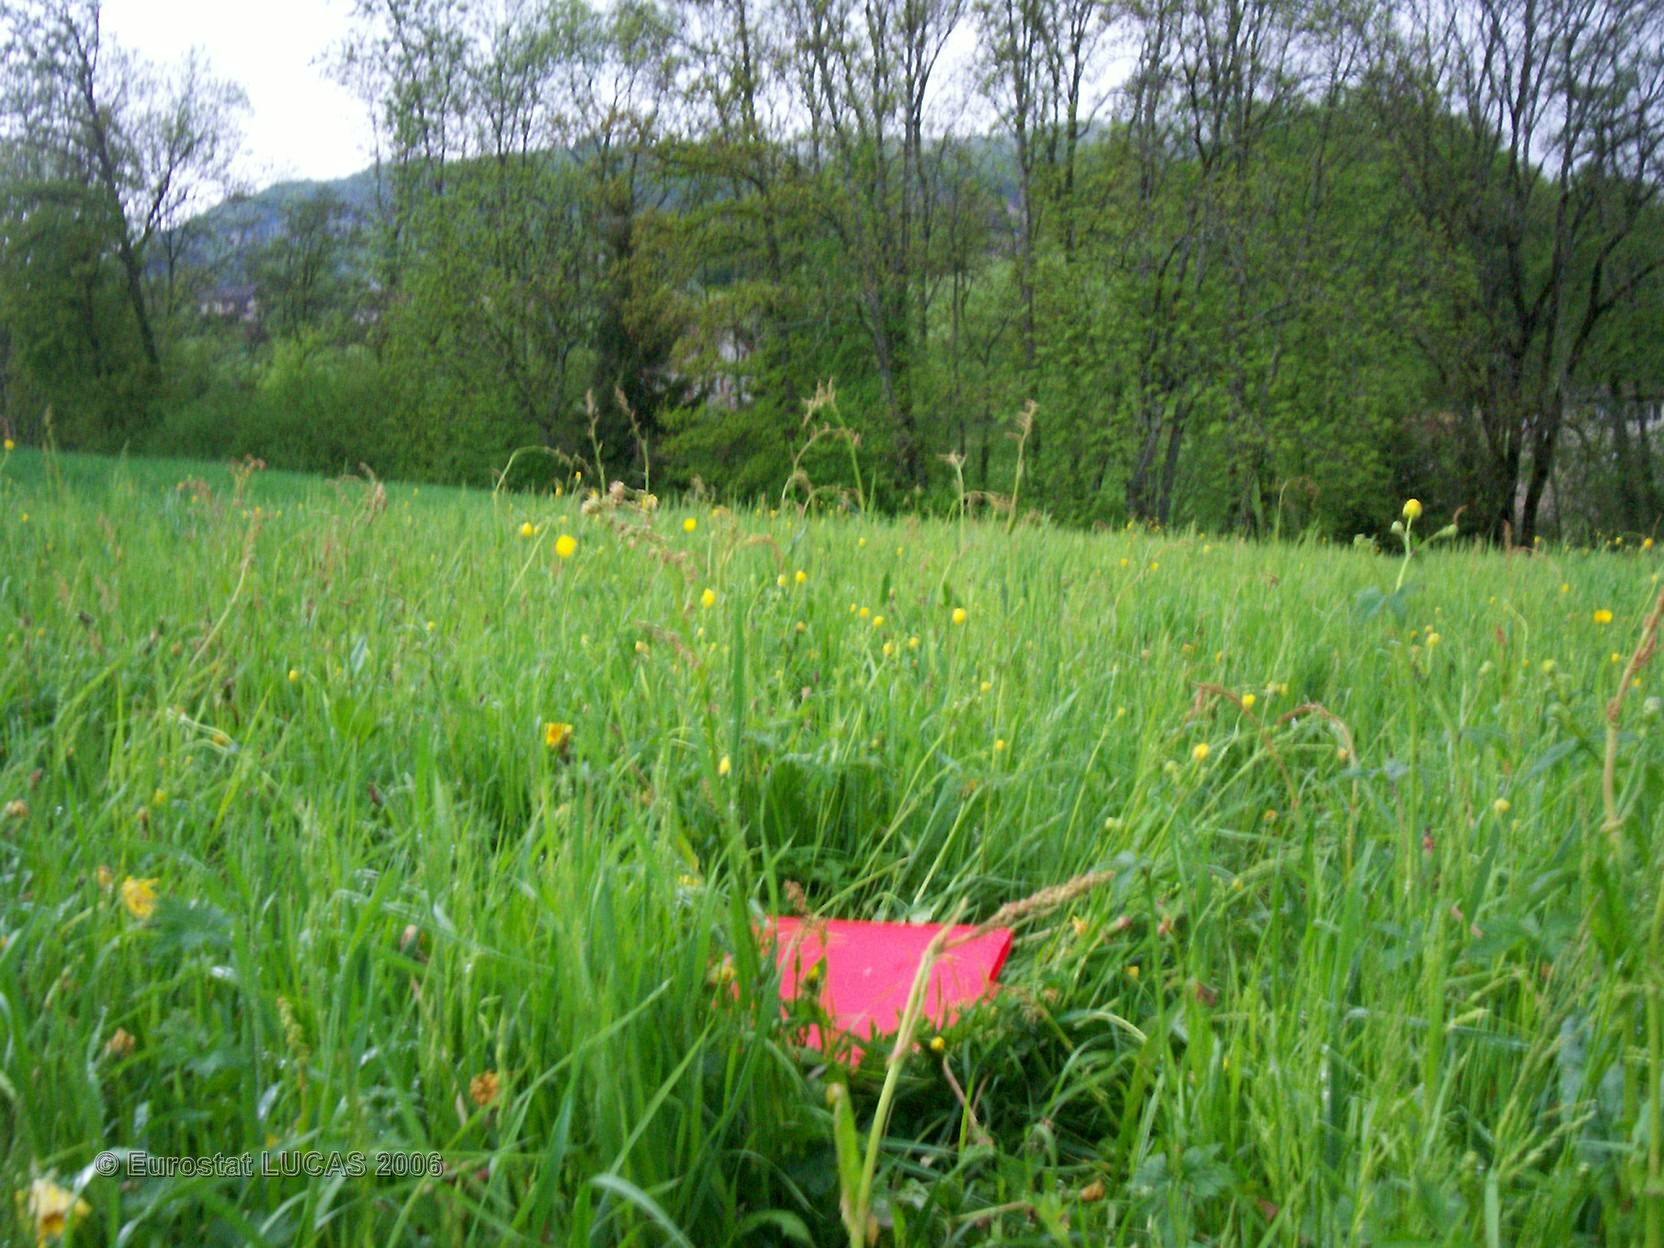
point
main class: Grassland
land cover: Grassland without tree/shrub cover
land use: Agriculture (excluding fallow land and kitchen gardens)
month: May
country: FR
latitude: 45.9922
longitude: 6.1177
